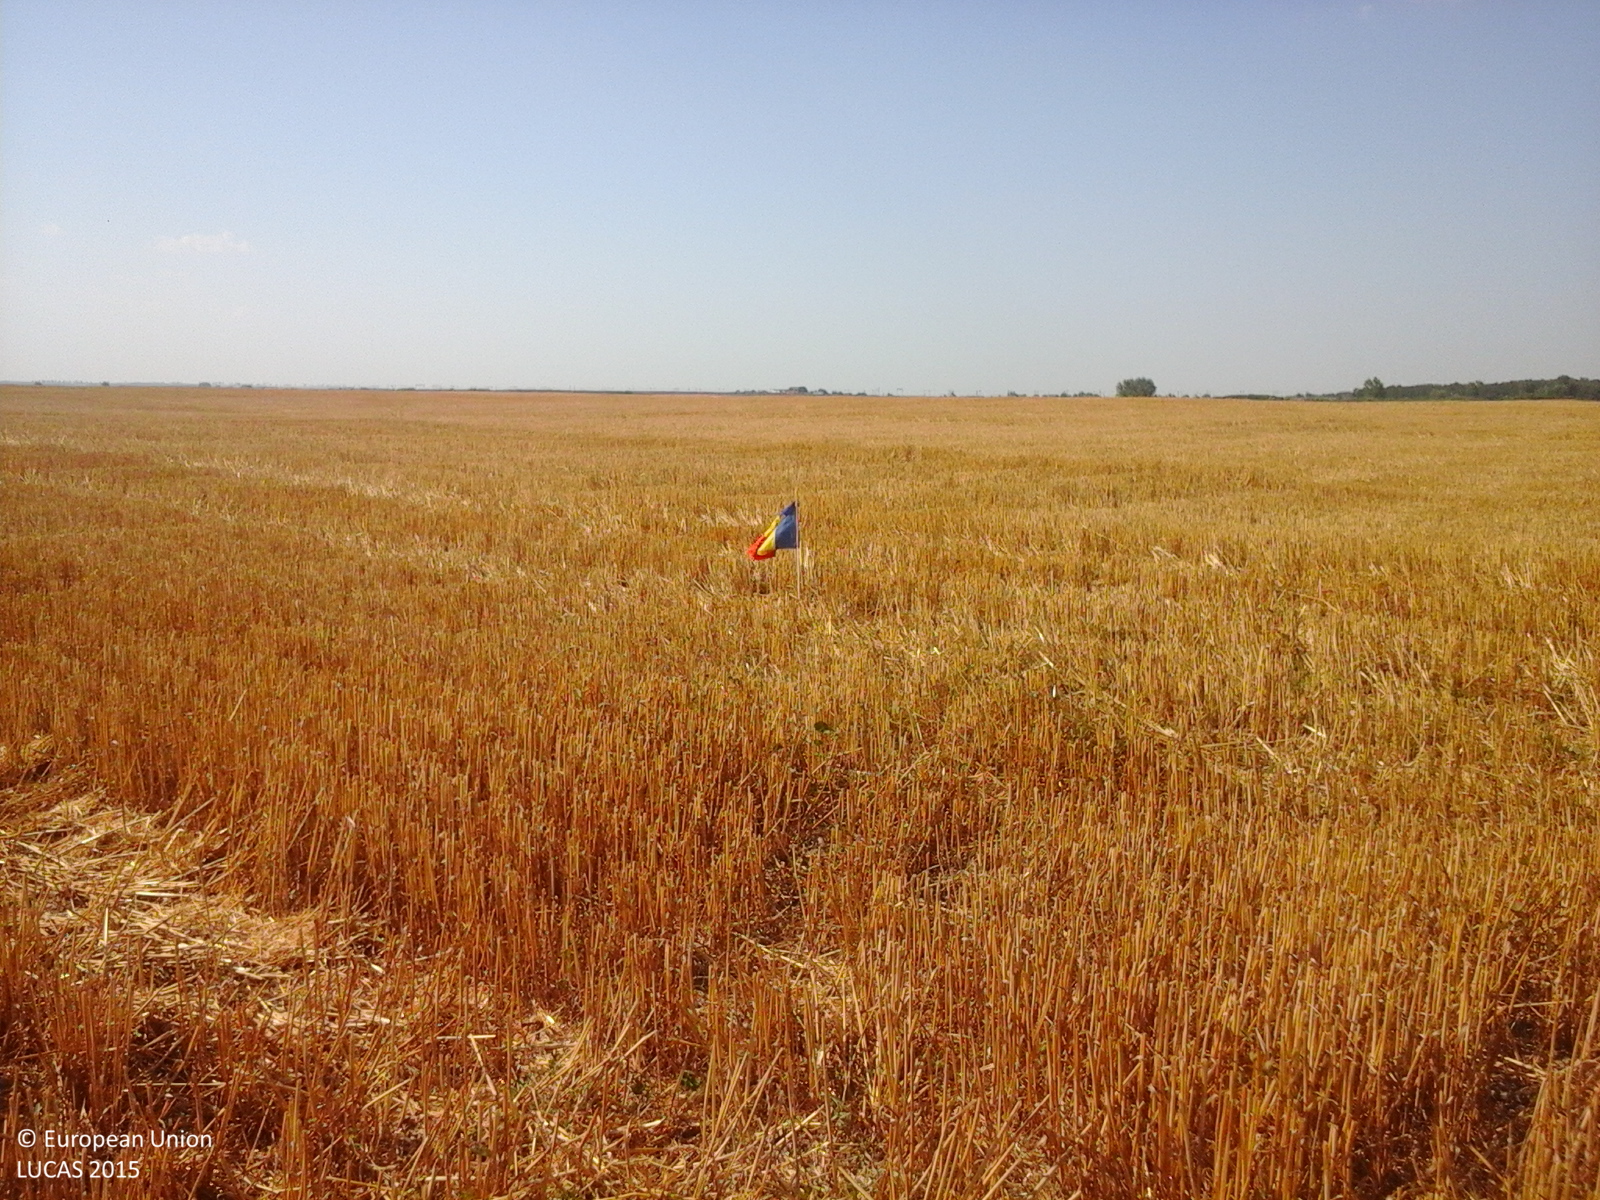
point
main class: Cropland
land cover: Common wheat
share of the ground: < 10 %
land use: Agriculture (excluding fallow land and kitchen gardens)
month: July
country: RO
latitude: 44.3325
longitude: 27.9761
